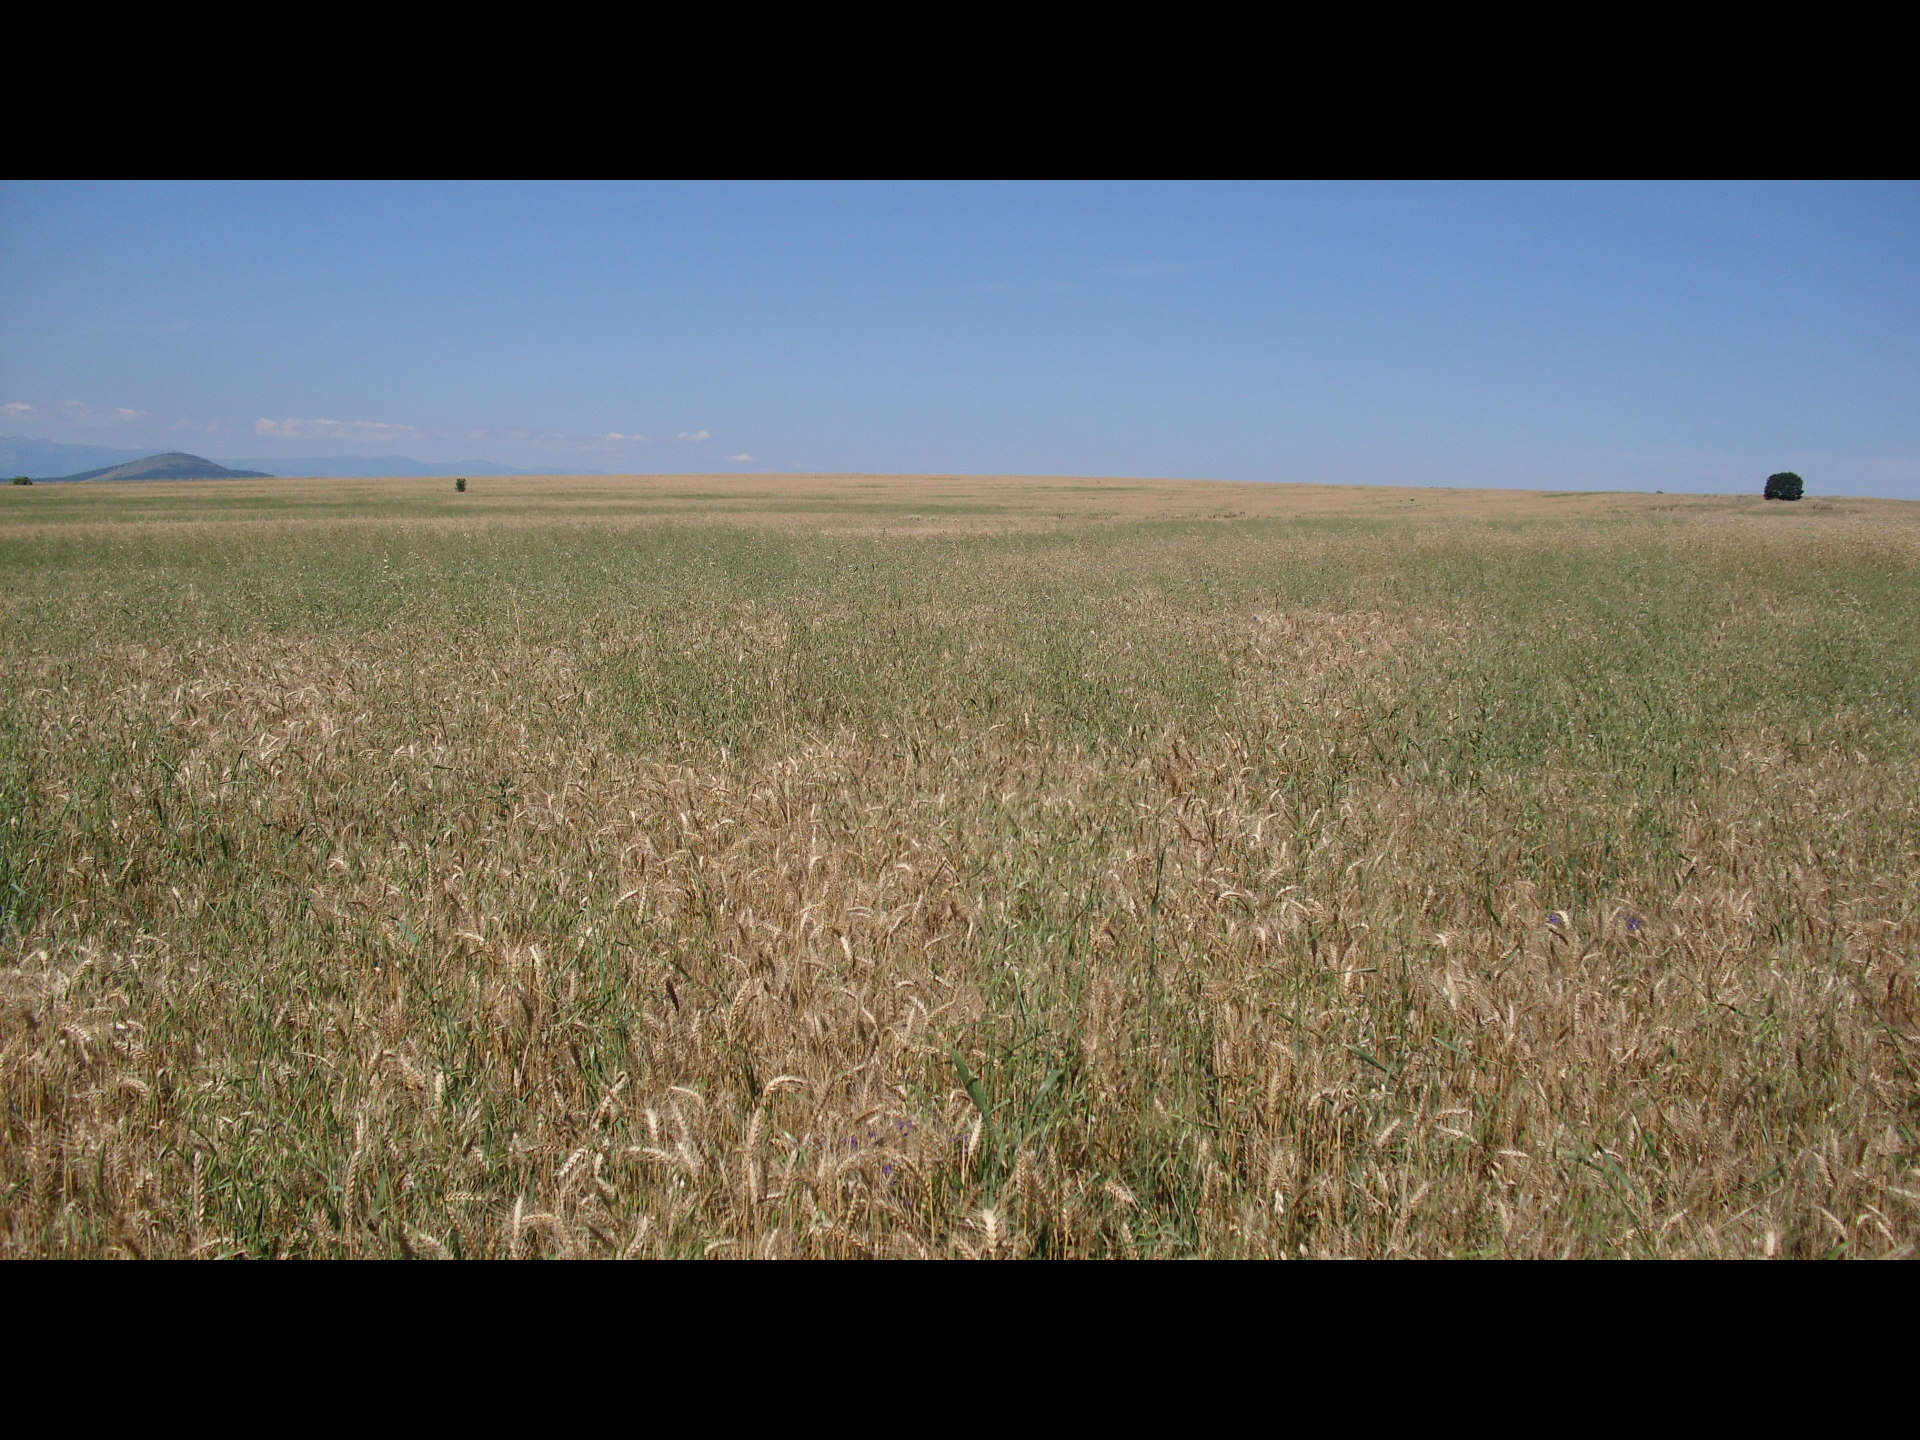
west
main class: Cropland
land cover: Common wheat
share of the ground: > 75 %
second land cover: Oats
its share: 10 - 25 %
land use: Agriculture (excluding fallow land and kitchen gardens)
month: June
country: BG
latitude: 43.4629
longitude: 23.2282
